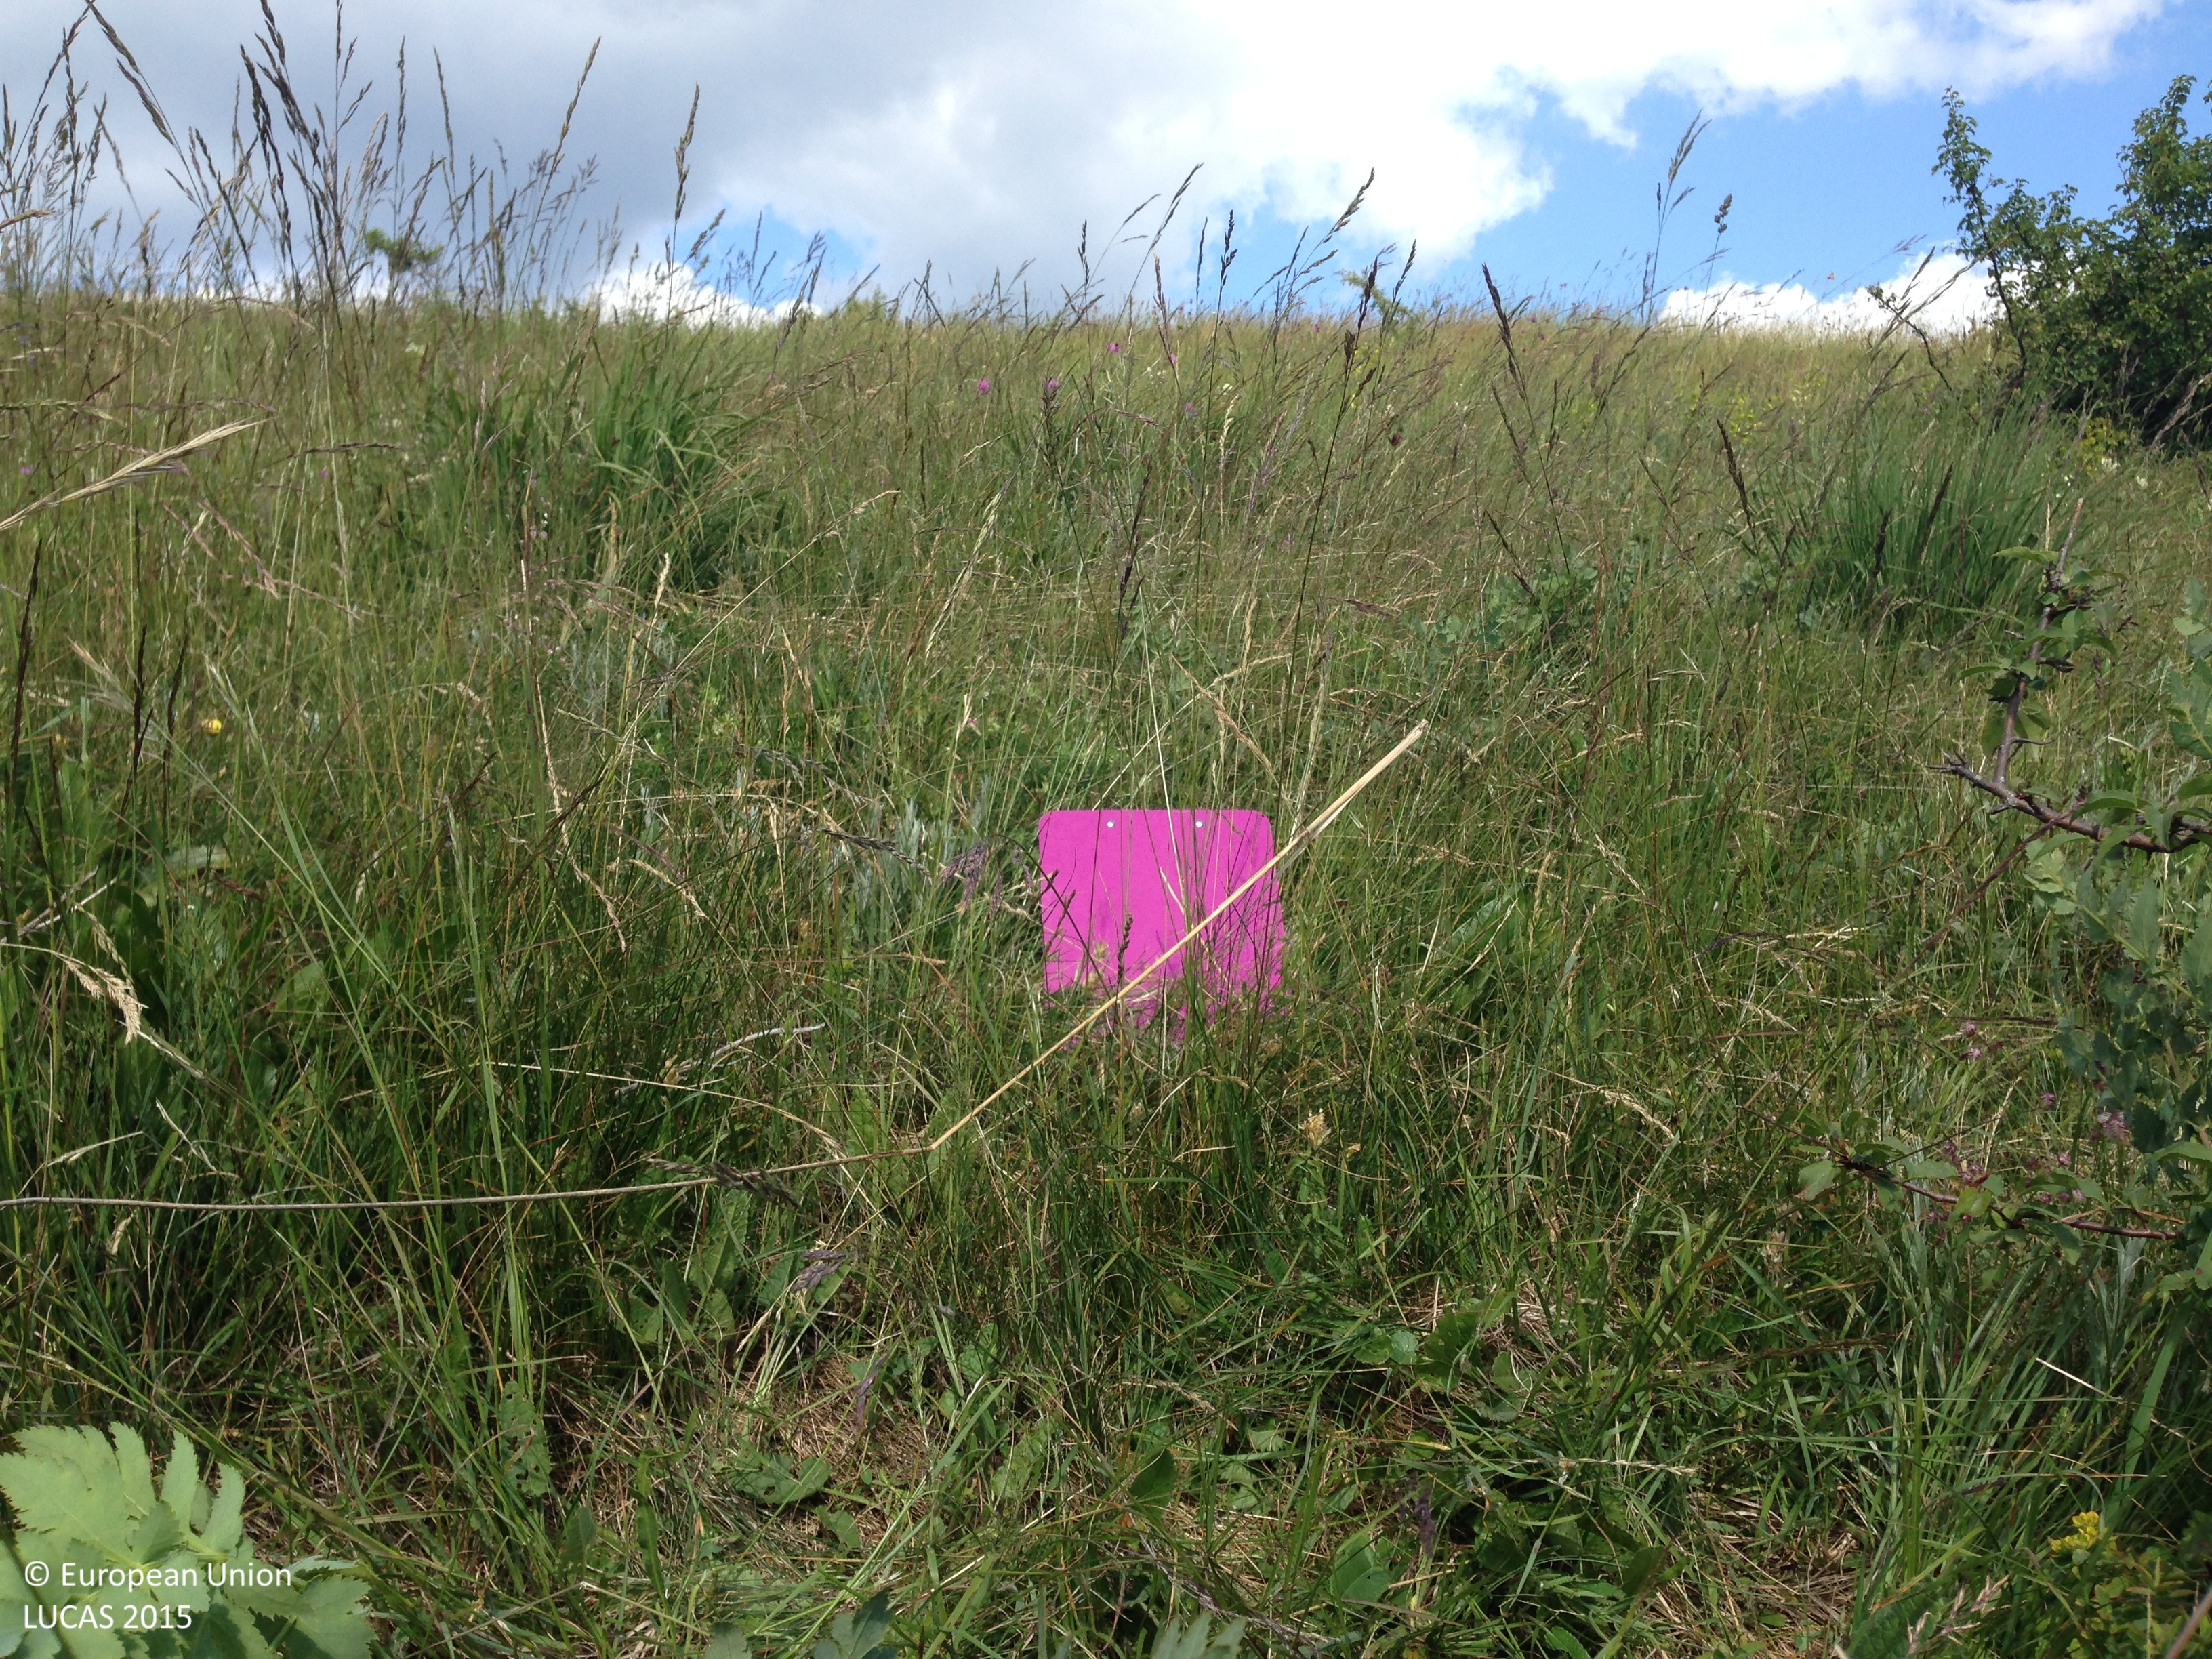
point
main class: Grassland
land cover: Grassland with sparse tree/shrub cover
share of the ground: > 75 %
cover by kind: herbaceous plants 85 %, broadleaved forest trees 5 %, shrubs 5 %, unconsolidated bare surface 5 %
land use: Agriculture (excluding fallow land and kitchen gardens)
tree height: < 5 m
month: June
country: HR
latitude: 44.7587
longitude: 15.6159
